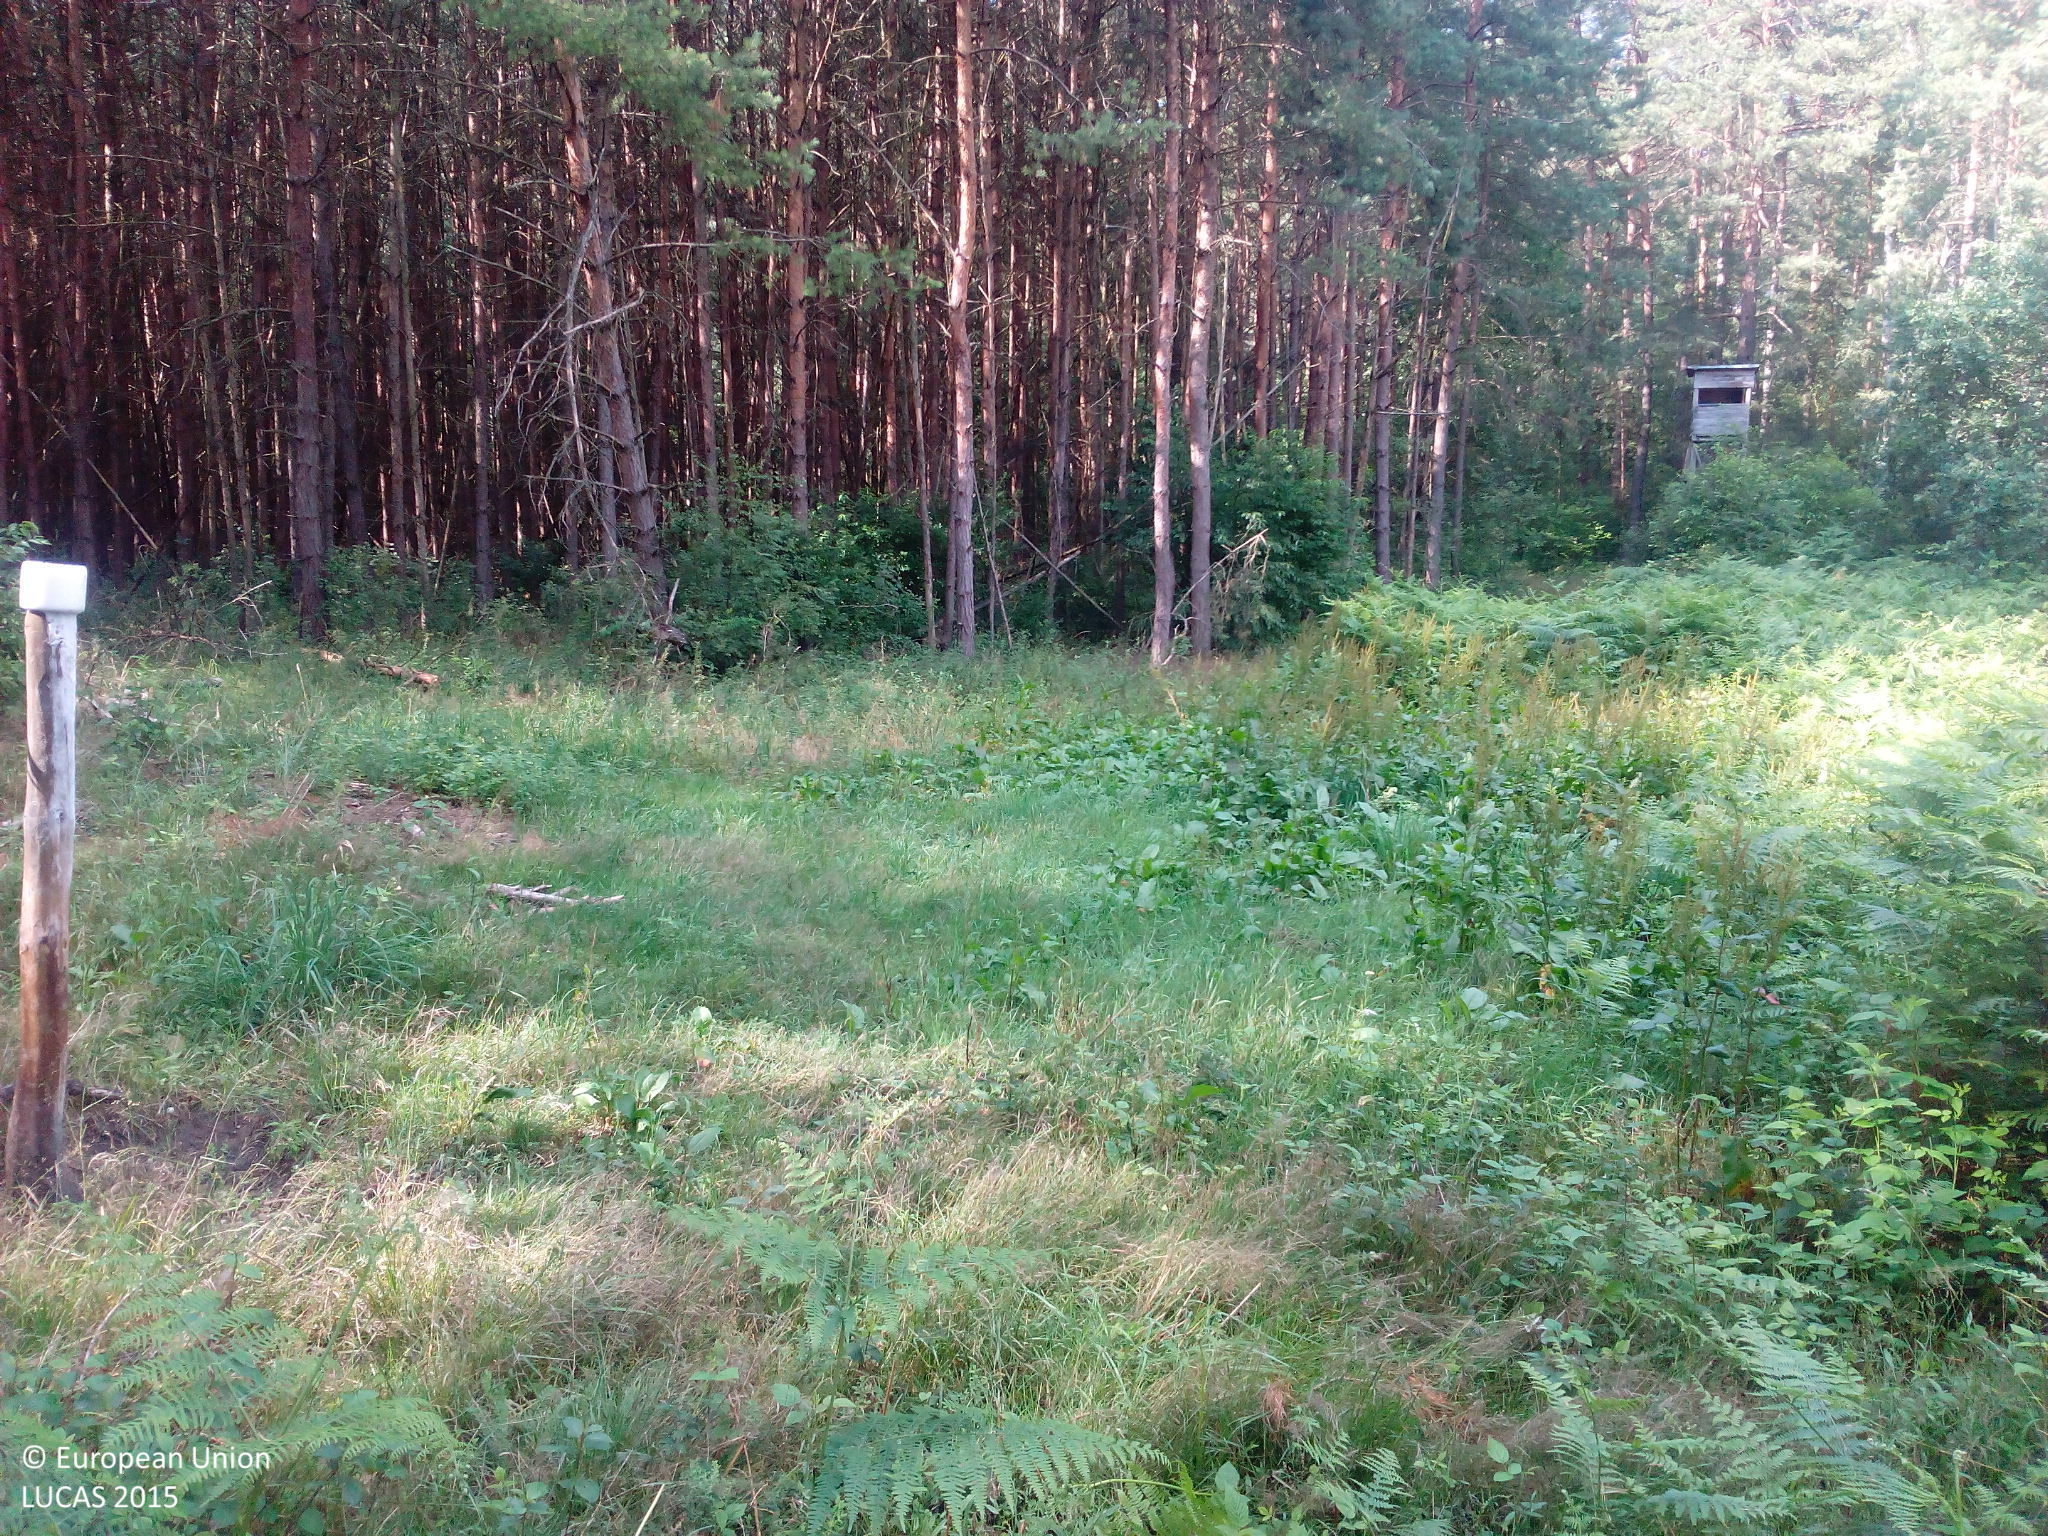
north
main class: Woodland
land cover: Pine dominated coniferous woodland
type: hemiboreal forest and nemoral coniferous forest and mixed broadleaved-coniferous forest
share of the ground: > 75 %
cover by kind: coniferous forest trees 95 %, herbaceous plants 5 %
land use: Forestry
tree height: > 5 m
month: July
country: DE
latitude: 51.9366
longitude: 12.5451
